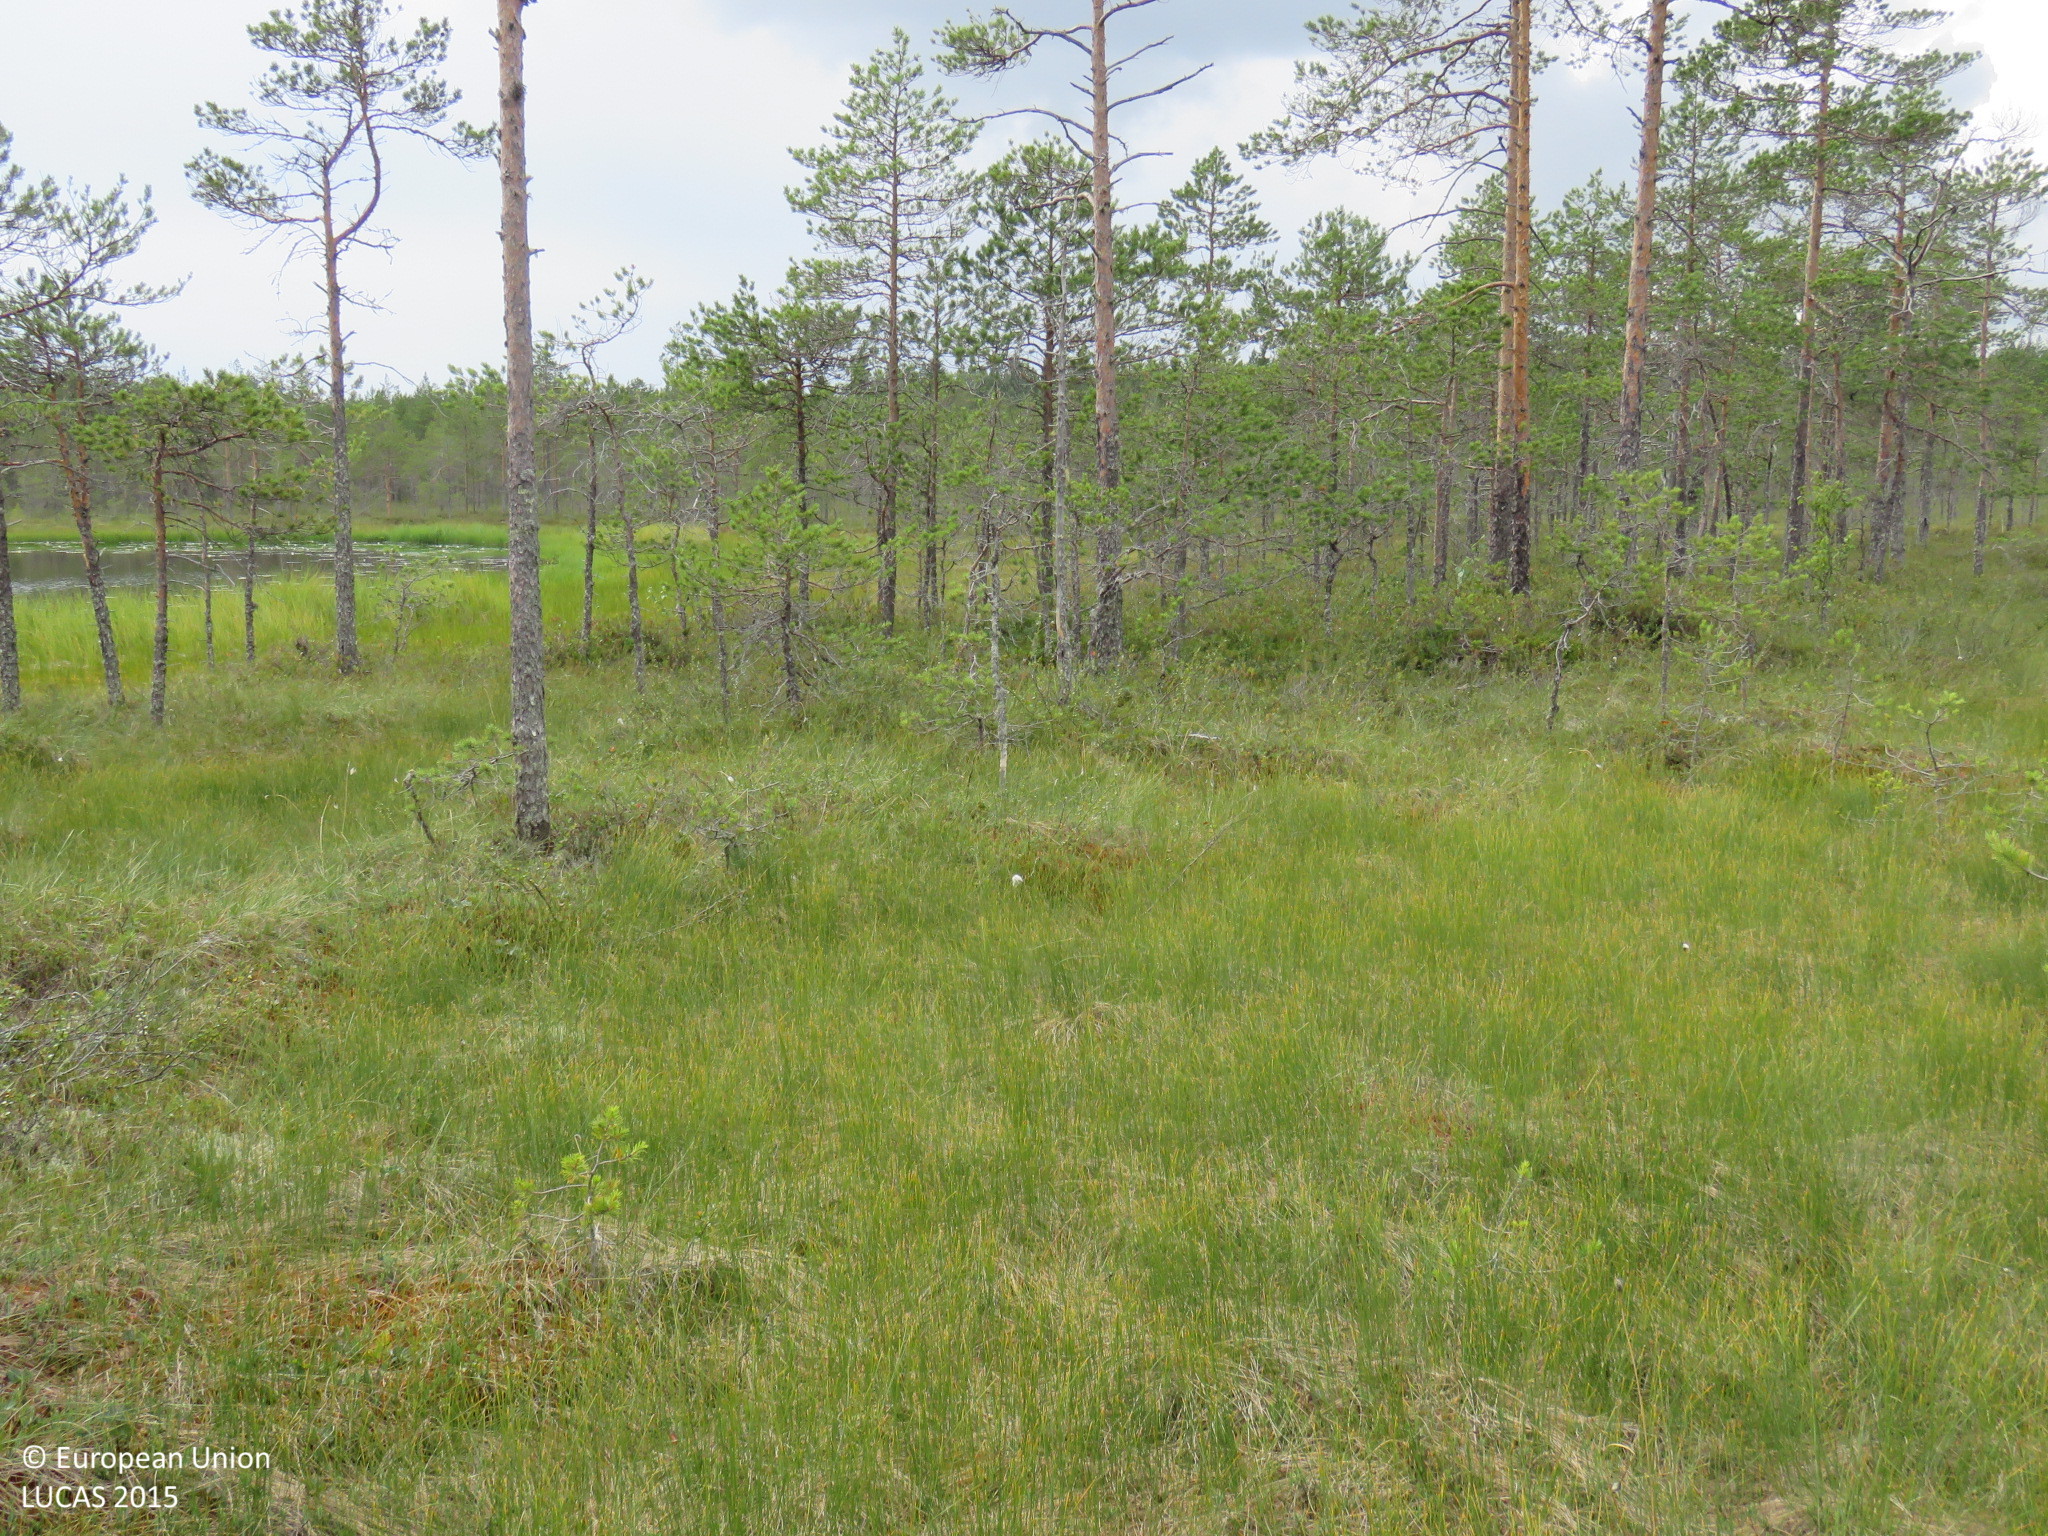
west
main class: Woodland
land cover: Pine dominated coniferous woodland
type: mire and swamp forests
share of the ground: 25 - 50 %
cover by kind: herbaceous plants 65 %, coniferous forest trees 25 %, shrubs 5 %, lichens and mosses 5 %
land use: Semi-natural and natural areas not in use
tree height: < 5 m
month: July
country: FI
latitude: 64.2500
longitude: 26.3074
